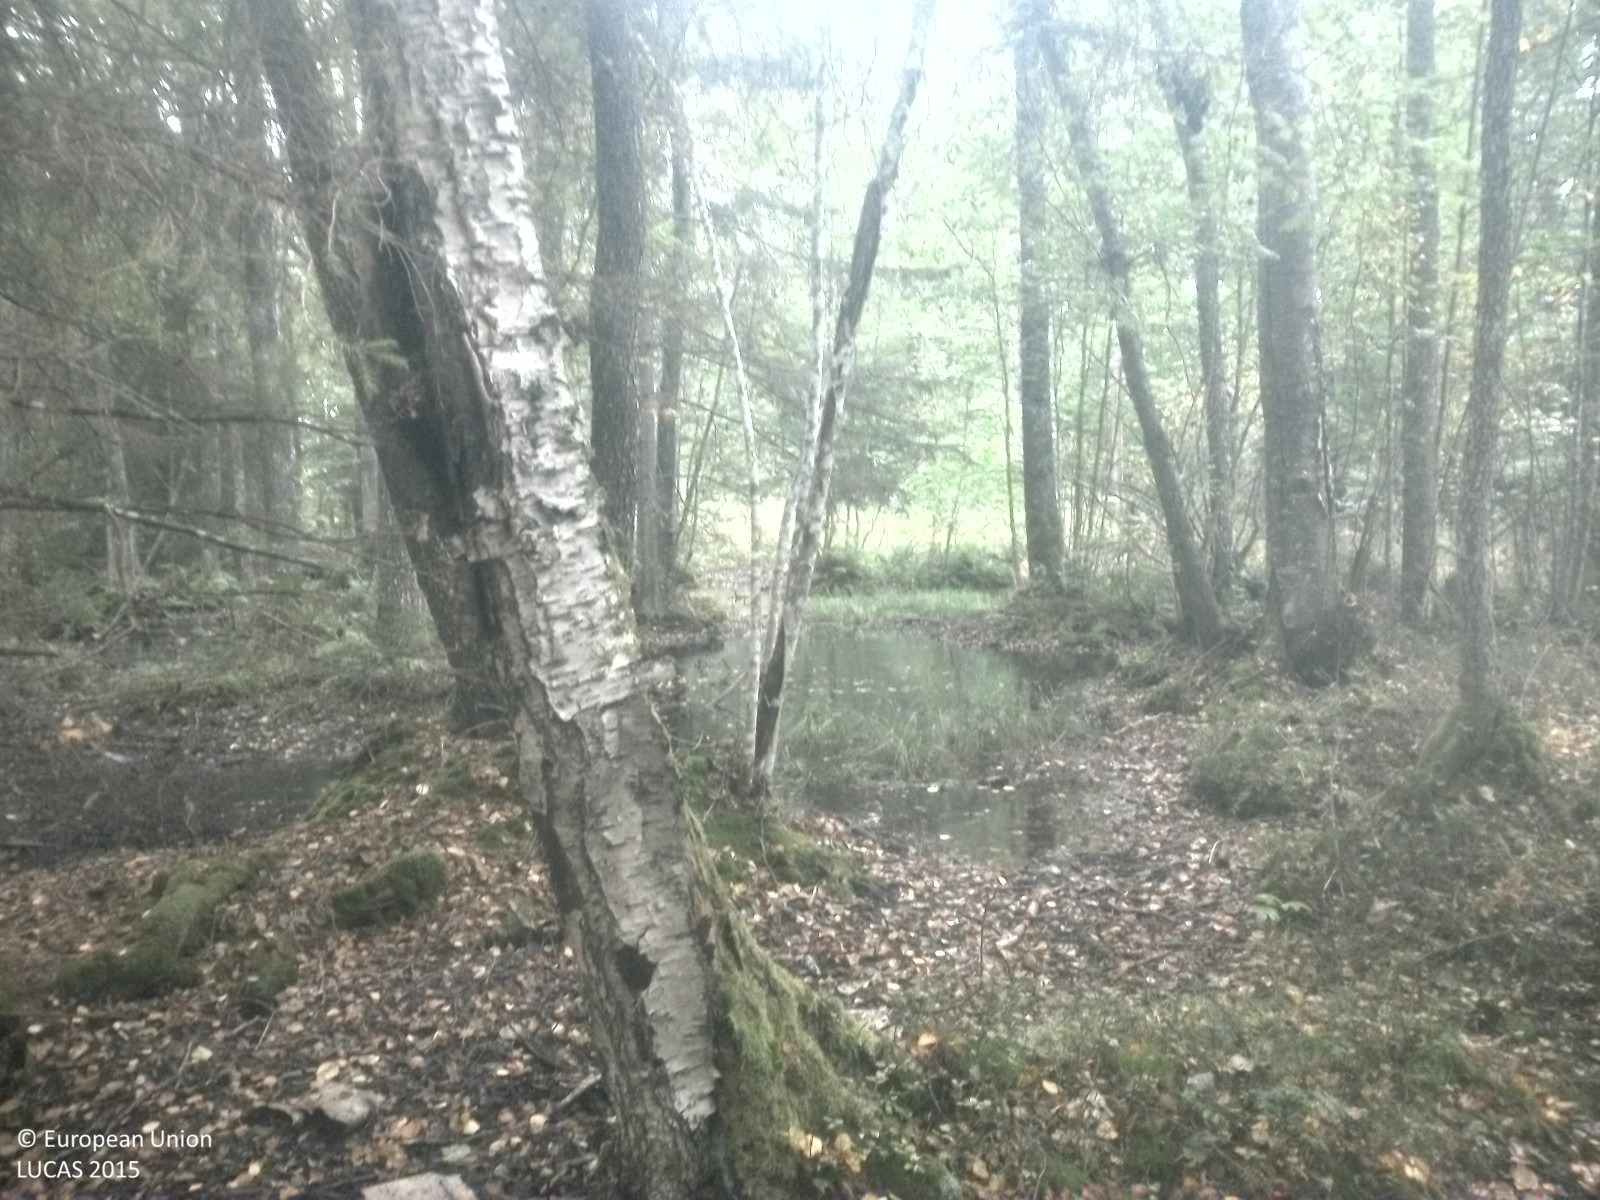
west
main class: Woodland
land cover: Broadleaved woodland
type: hemiboreal forest and nemoral coniferous forest and mixed broadleaved-coniferous forest
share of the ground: 50 - 75 %
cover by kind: broadleaved forest trees 55 %, unconsolidated bare surface 20 %, herbaceous plants 10 %, lichens and mosses 10 %, coniferous forest trees 5 %
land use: Forestry
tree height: > 5 m
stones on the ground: < 10 %
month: September
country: SE
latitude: 58.8923
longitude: 15.7025
